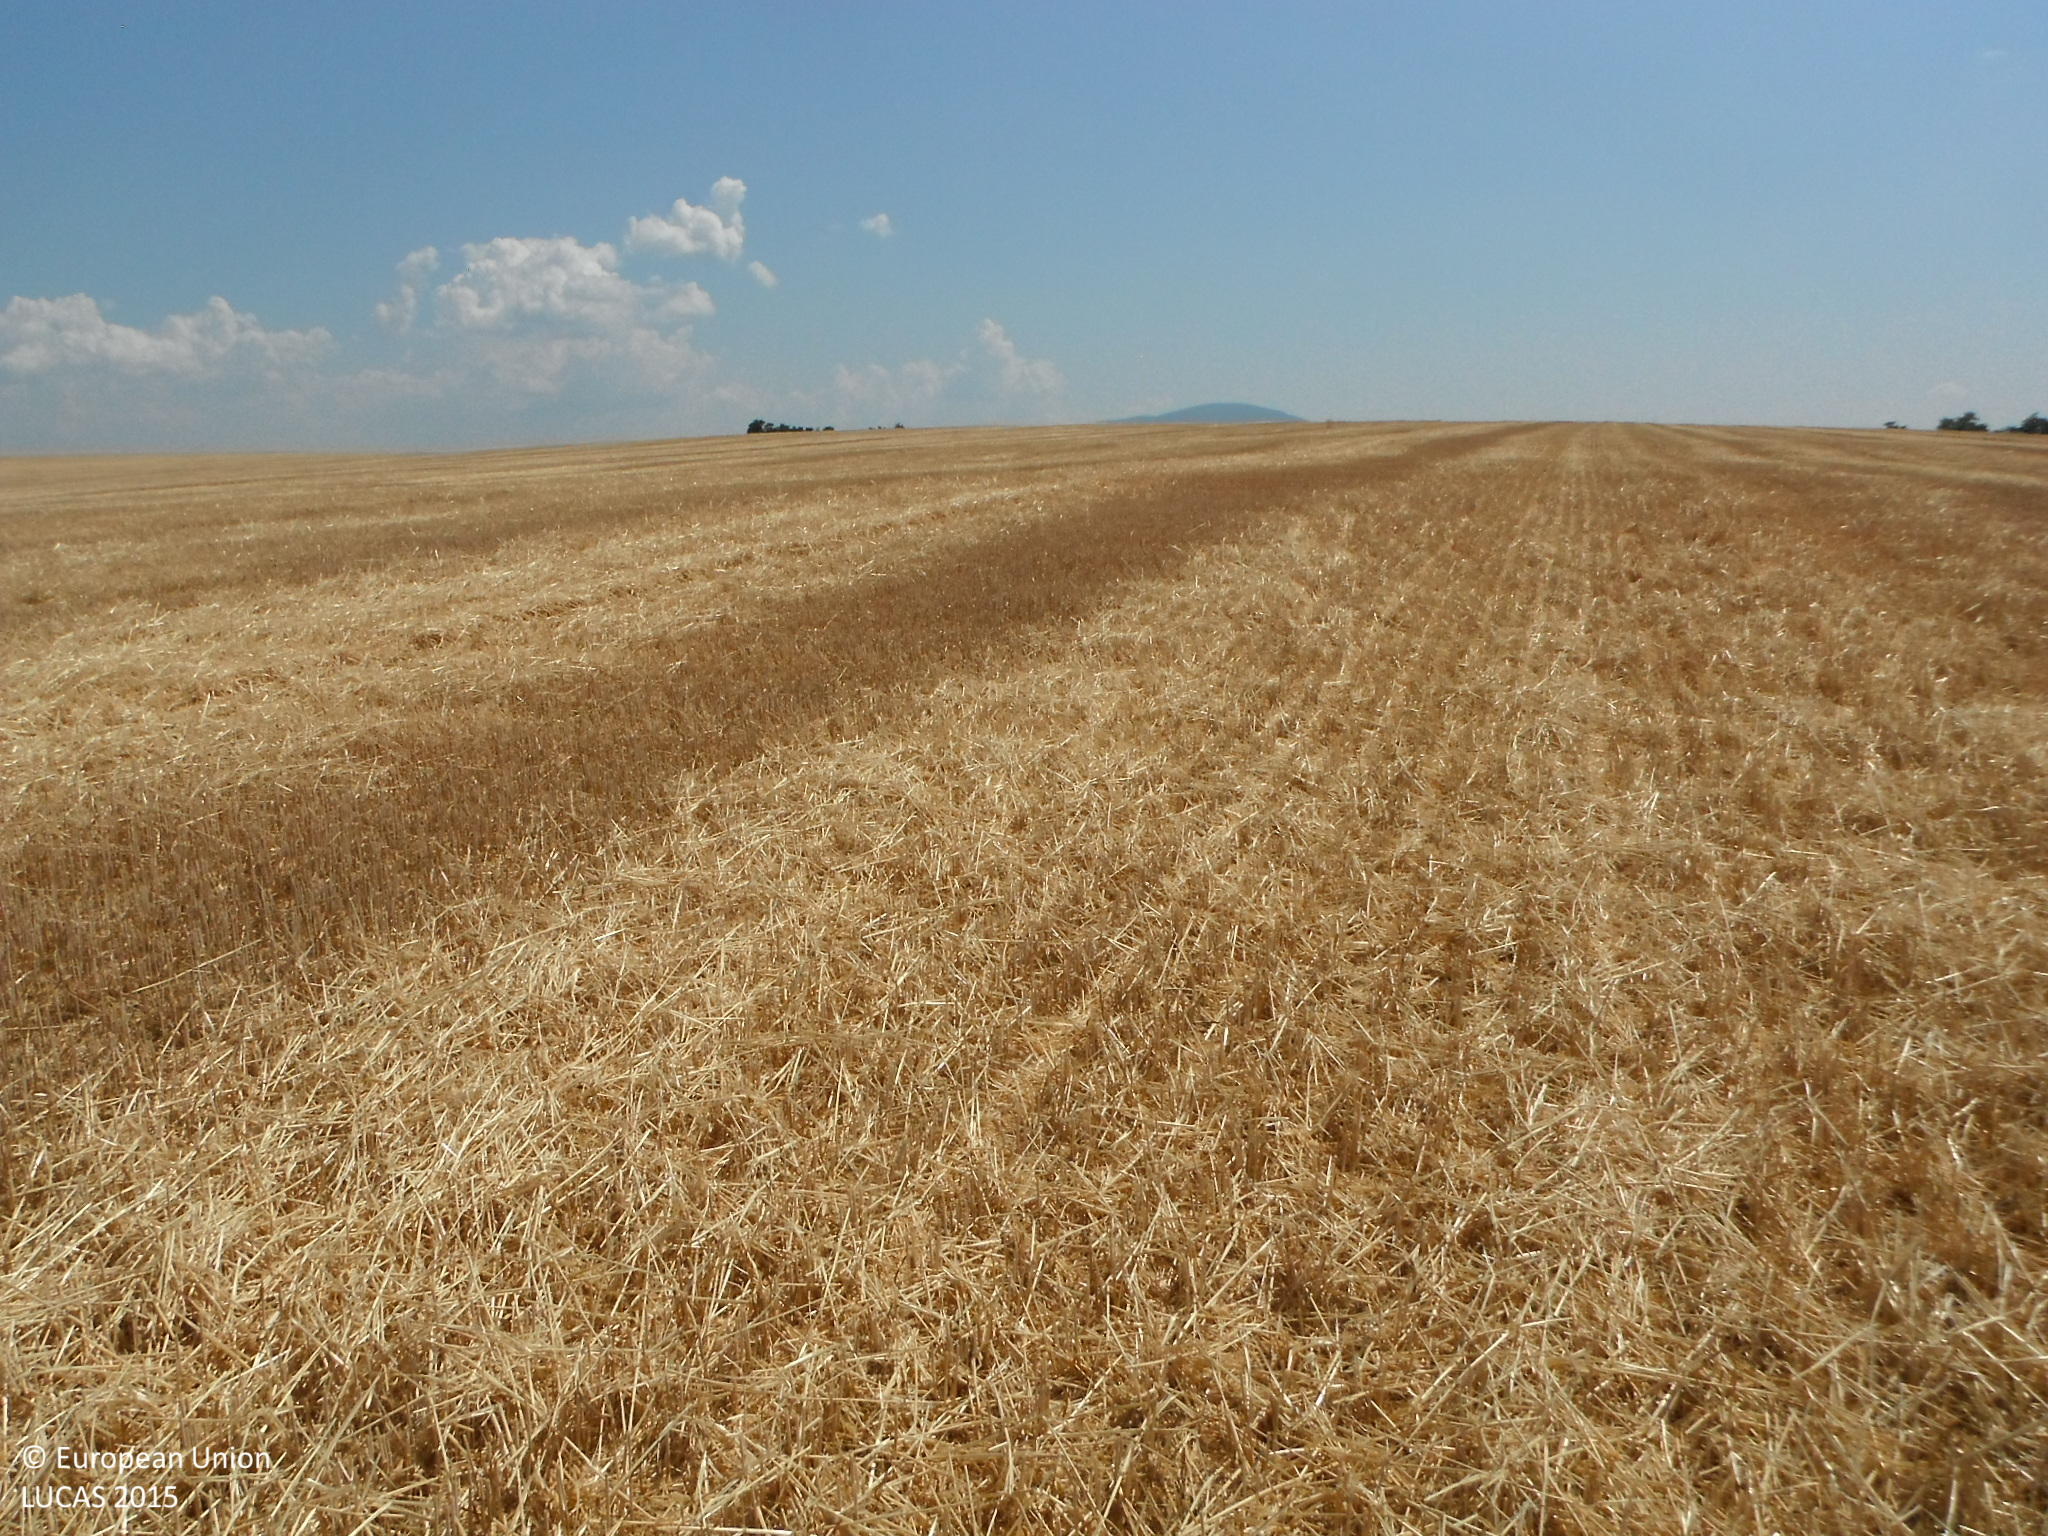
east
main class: Cropland
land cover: Common wheat
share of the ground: > 75 %
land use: Agriculture (excluding fallow land and kitchen gardens)
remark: Harvested field
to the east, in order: Common wheat
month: July
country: SK
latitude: 48.4883
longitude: 18.0646
